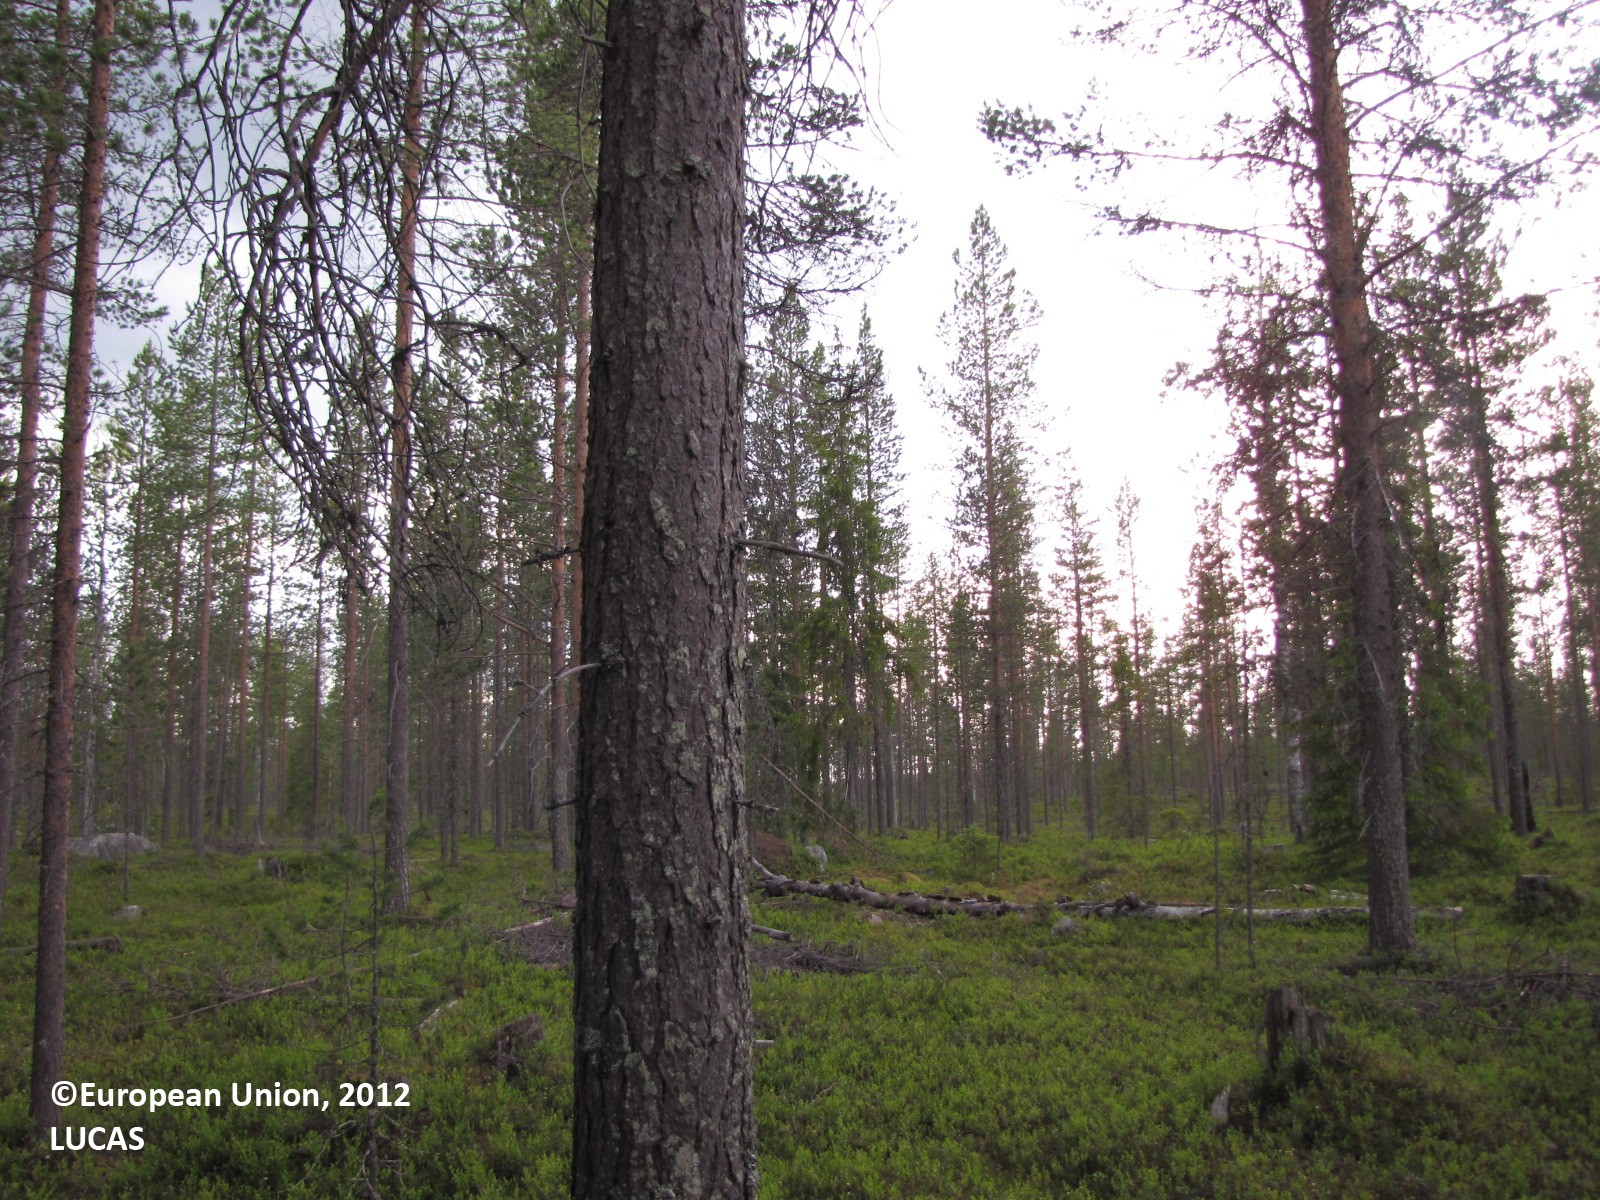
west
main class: Woodland
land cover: Pine dominated coniferous woodland
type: boreal forest
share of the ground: 50 - 75 %
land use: Forestry
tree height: > 5 m
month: July
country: FI
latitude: 66.3958
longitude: 25.2110
